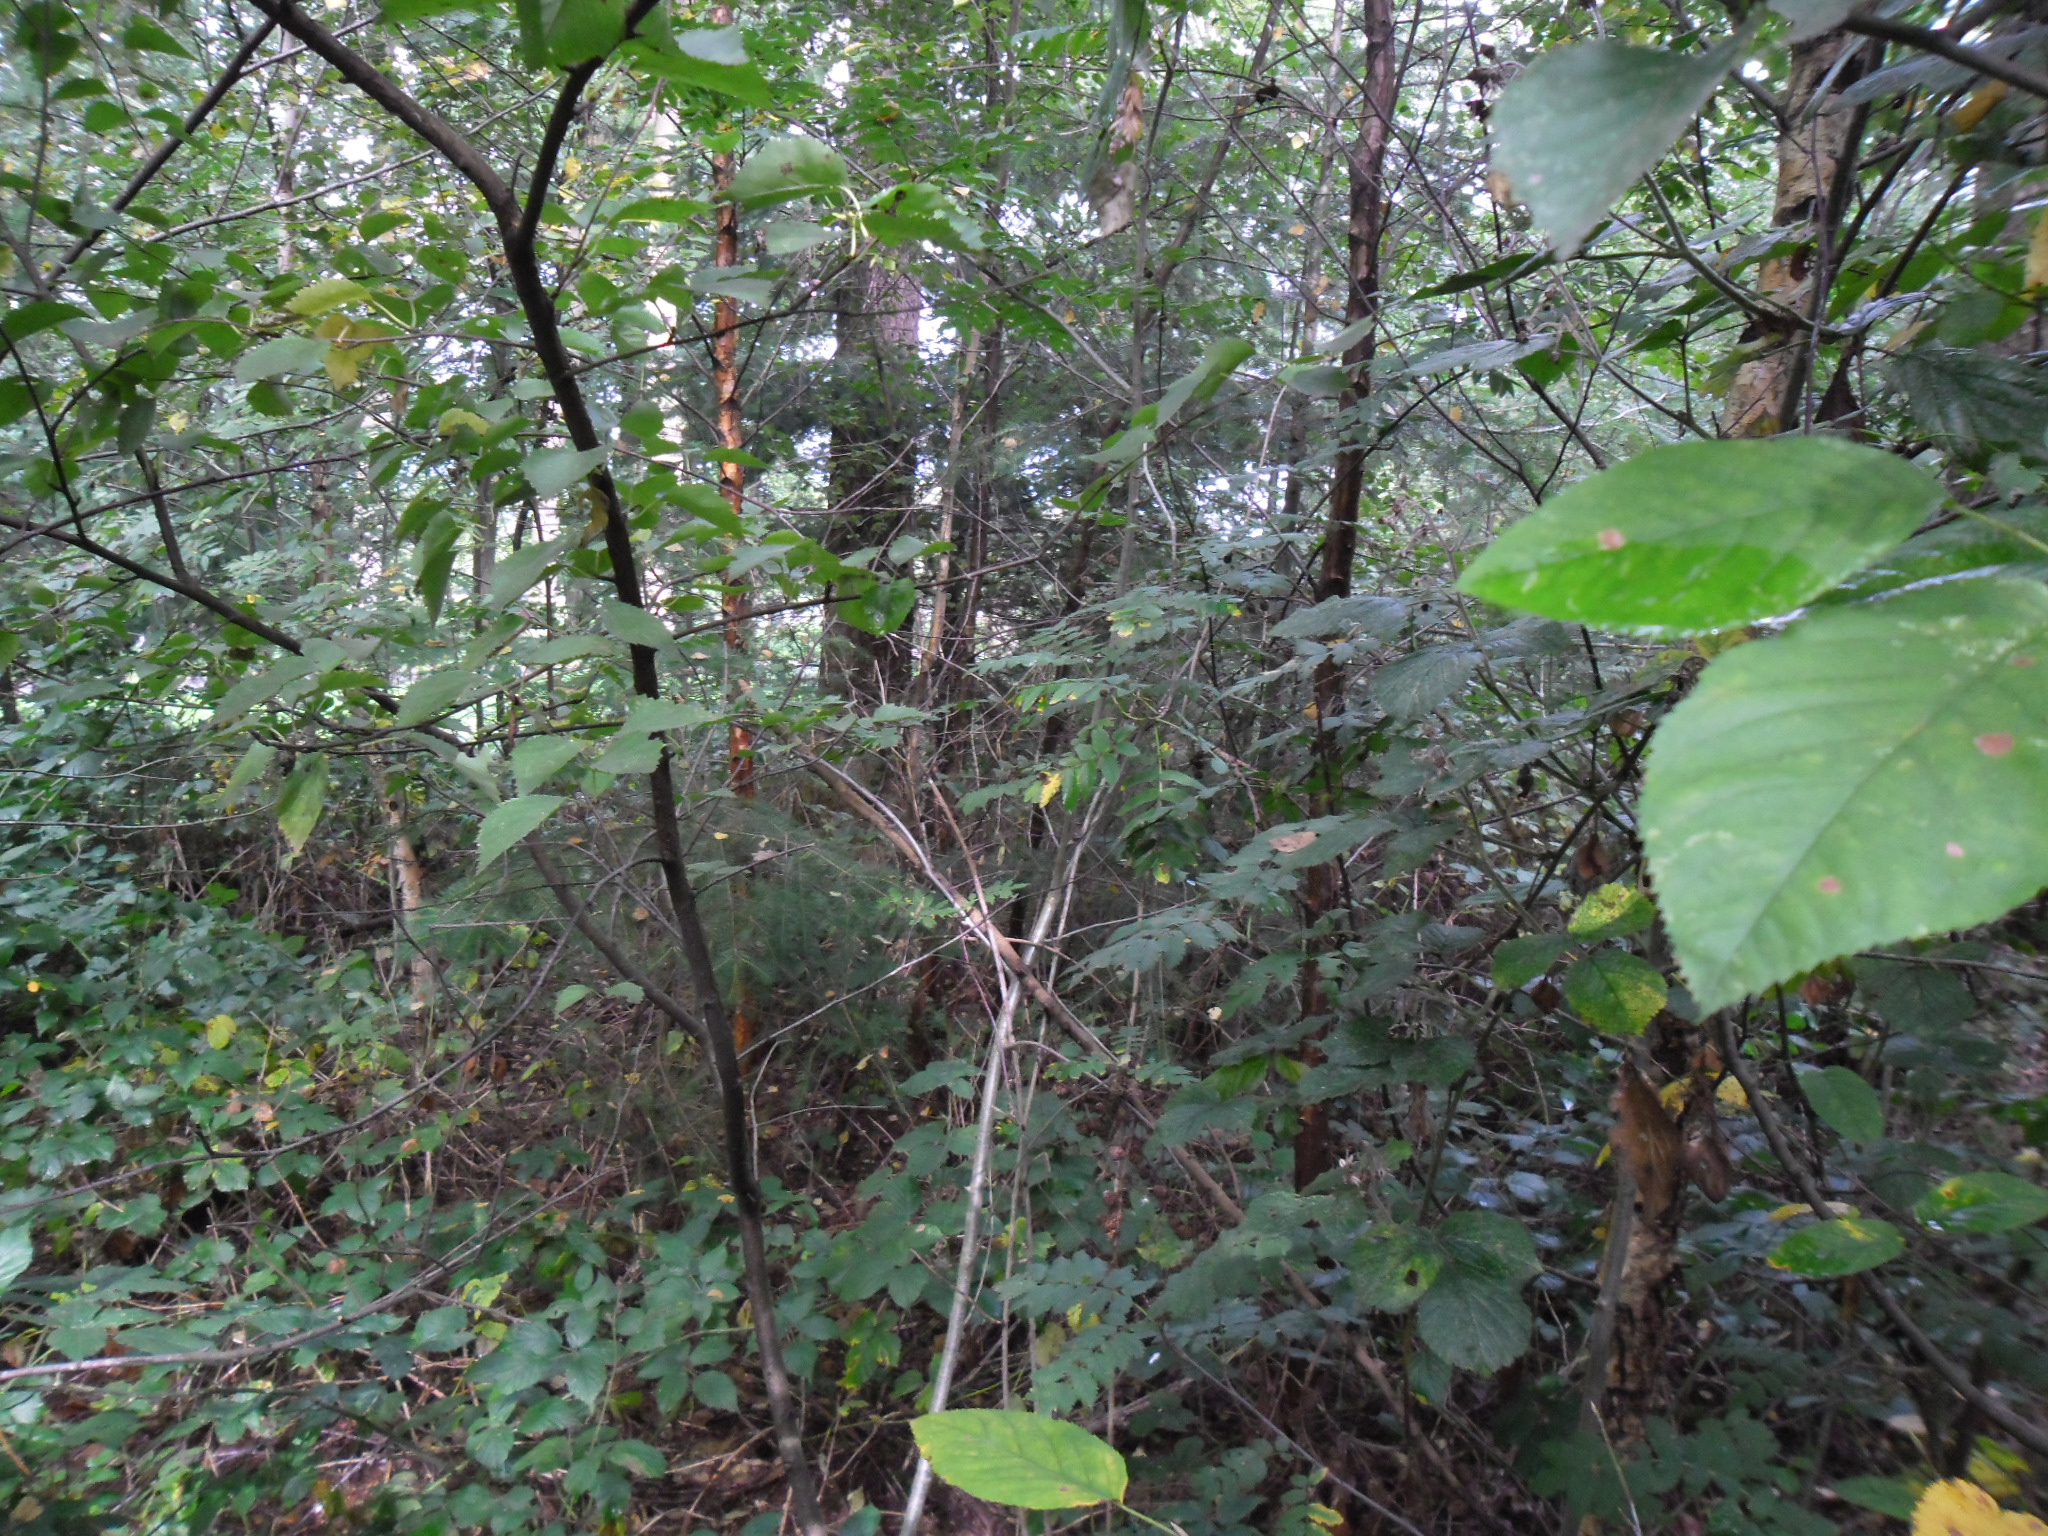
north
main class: Woodland
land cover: Other mixed woodland
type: mesophytic deciduous forest
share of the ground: > 75 %
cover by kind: broadleaved forest trees 60 %, coniferous forest trees 40 %
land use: Amenities, museums, leisure
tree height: > 5 m
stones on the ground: < 10 %
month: September
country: NL
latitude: 52.1296
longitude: 5.4844
